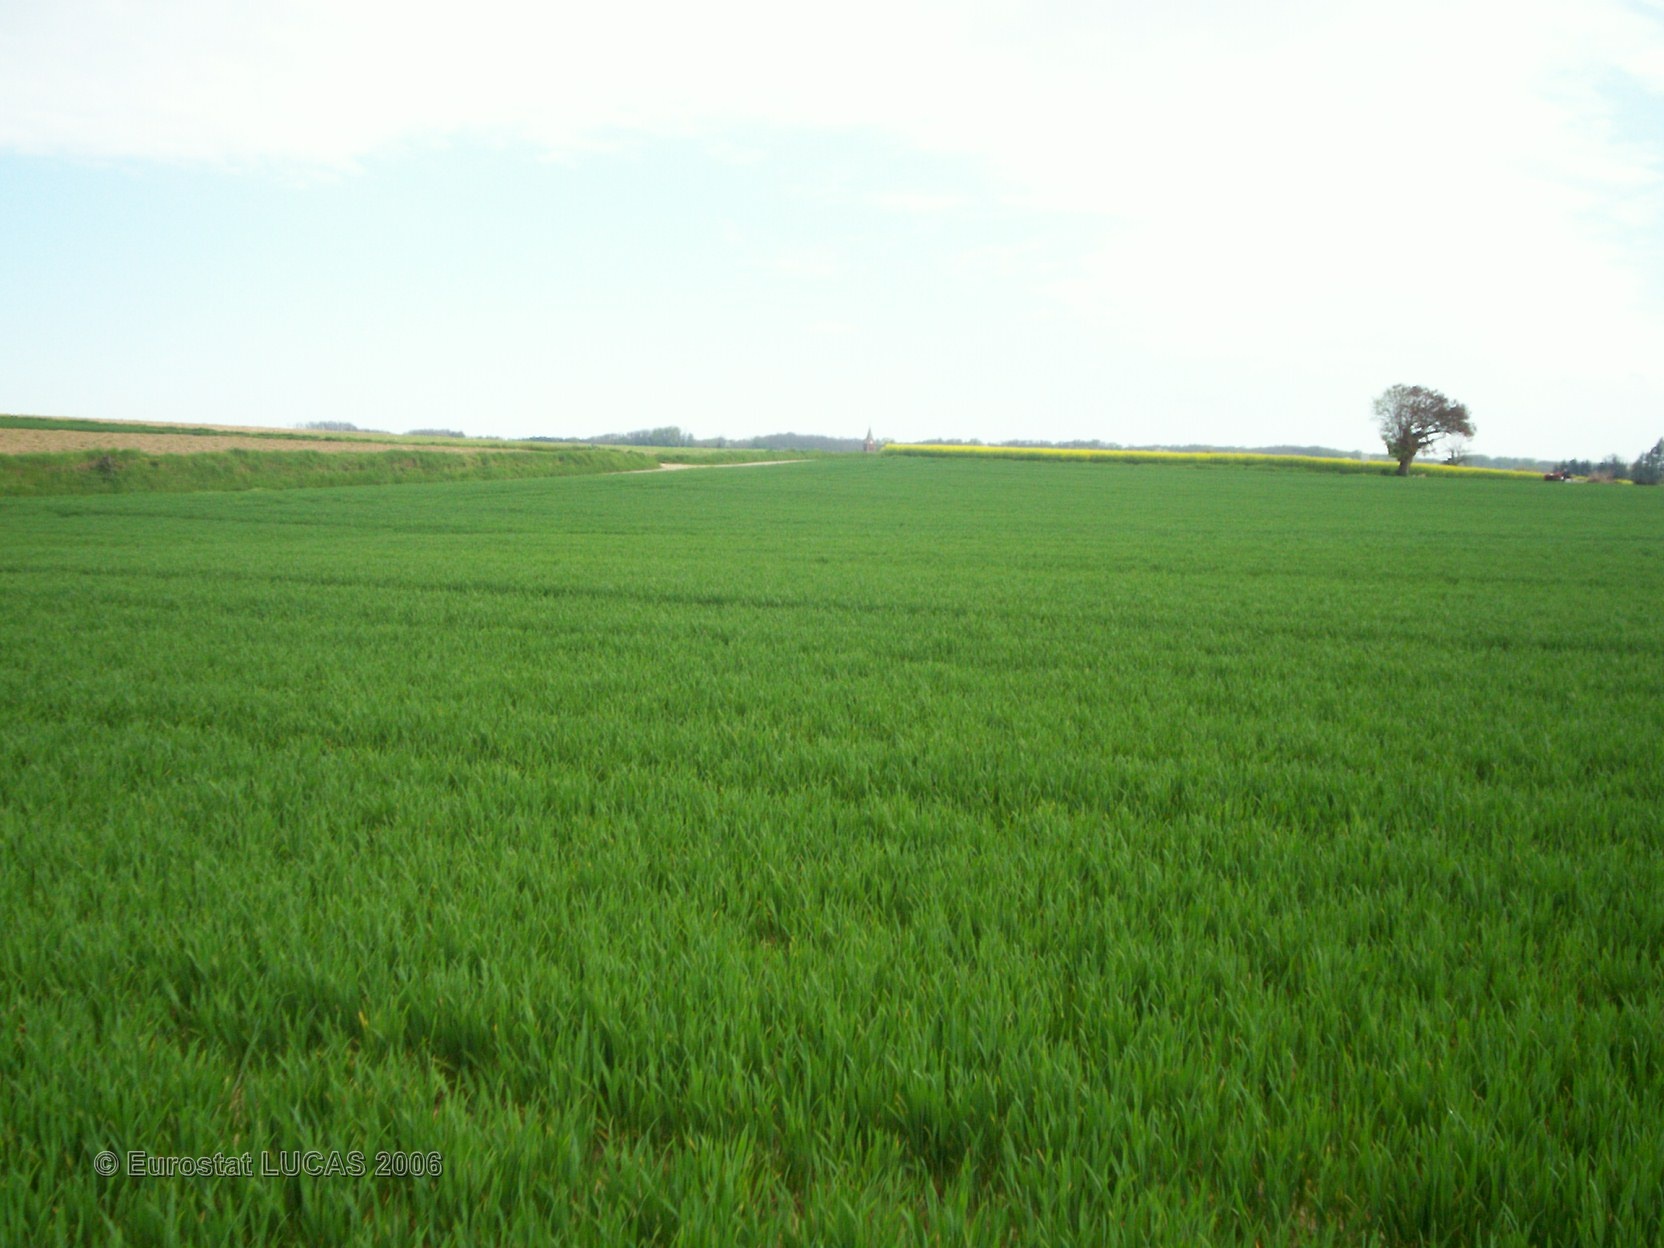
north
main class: Cropland
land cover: Common wheat
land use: Agriculture (excluding fallow land and kitchen gardens)
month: April
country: FR
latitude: 45.3565
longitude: 5.1412
